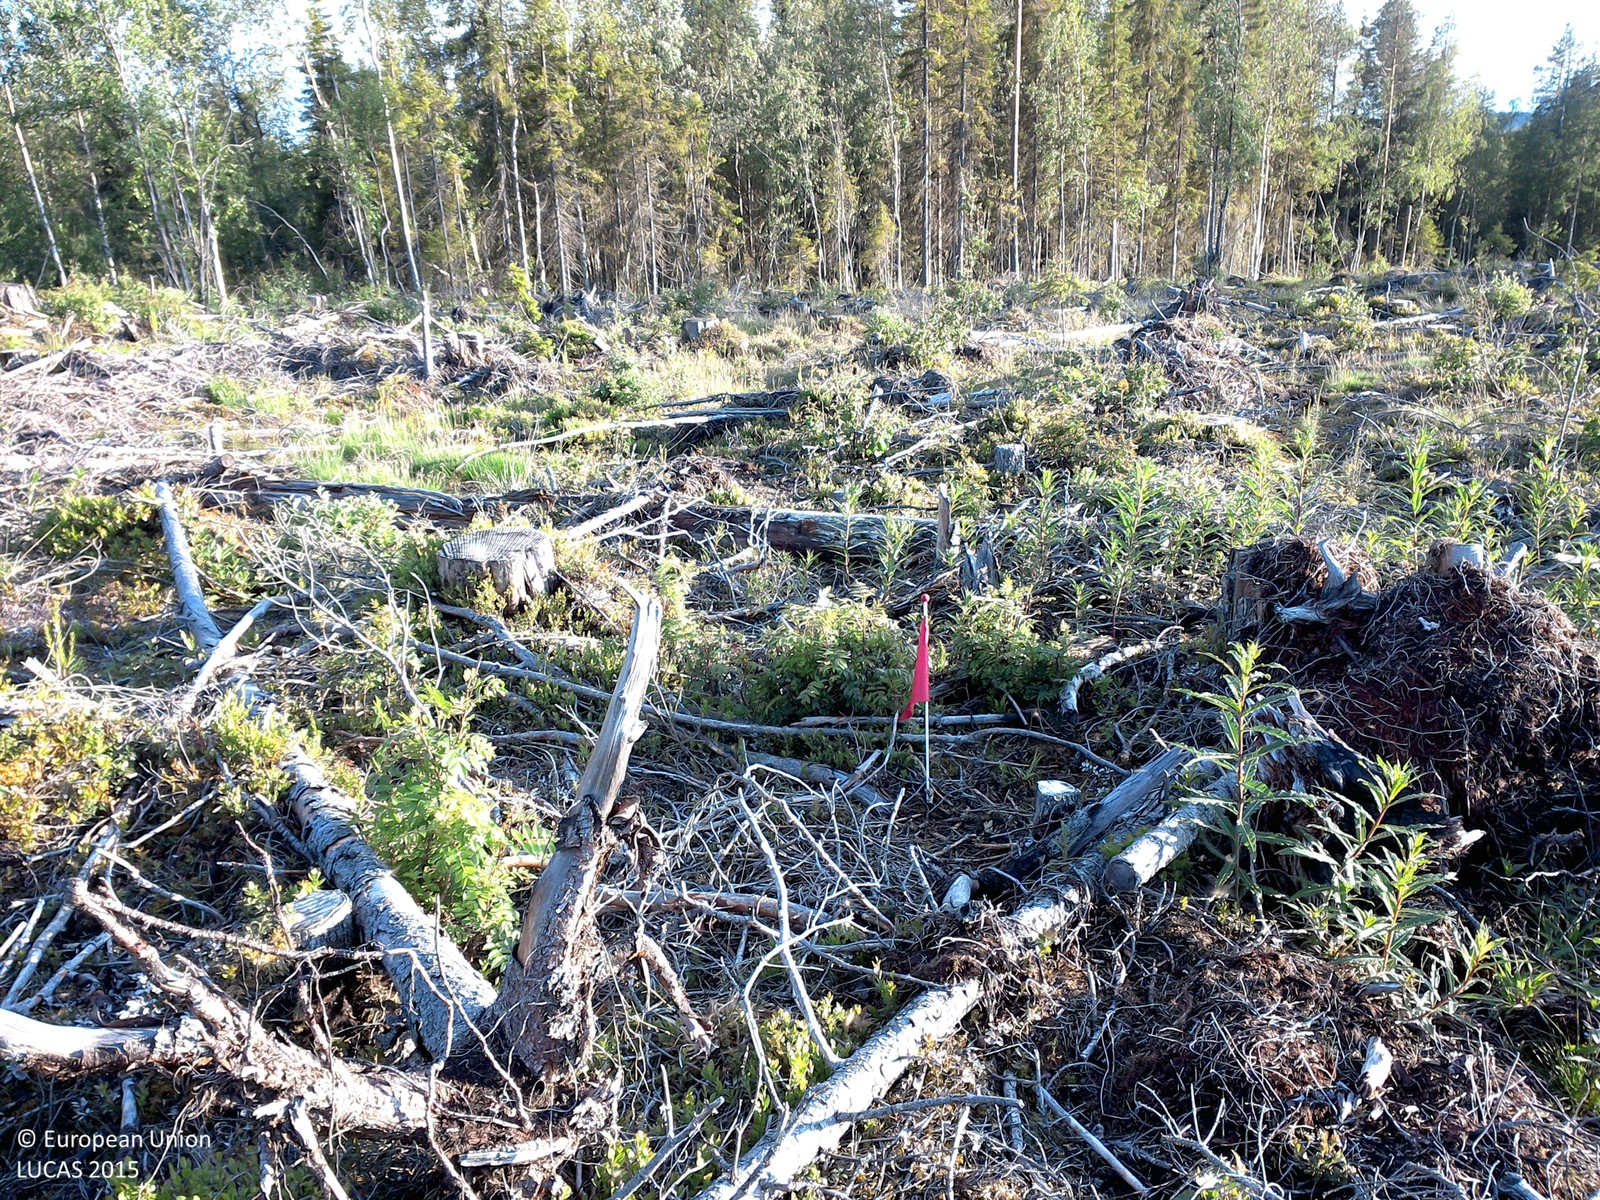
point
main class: Shrubland
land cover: Shrubland with sparse tree cover
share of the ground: 10 - 25 %
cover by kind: unconsolidated bare surface 45 %, shrubs 25 %, herbaceous plants 25 %, broadleaved forest trees 5 %
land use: Forestry
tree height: < 5 m
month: July
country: SE
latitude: 66.8864
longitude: 23.0994
